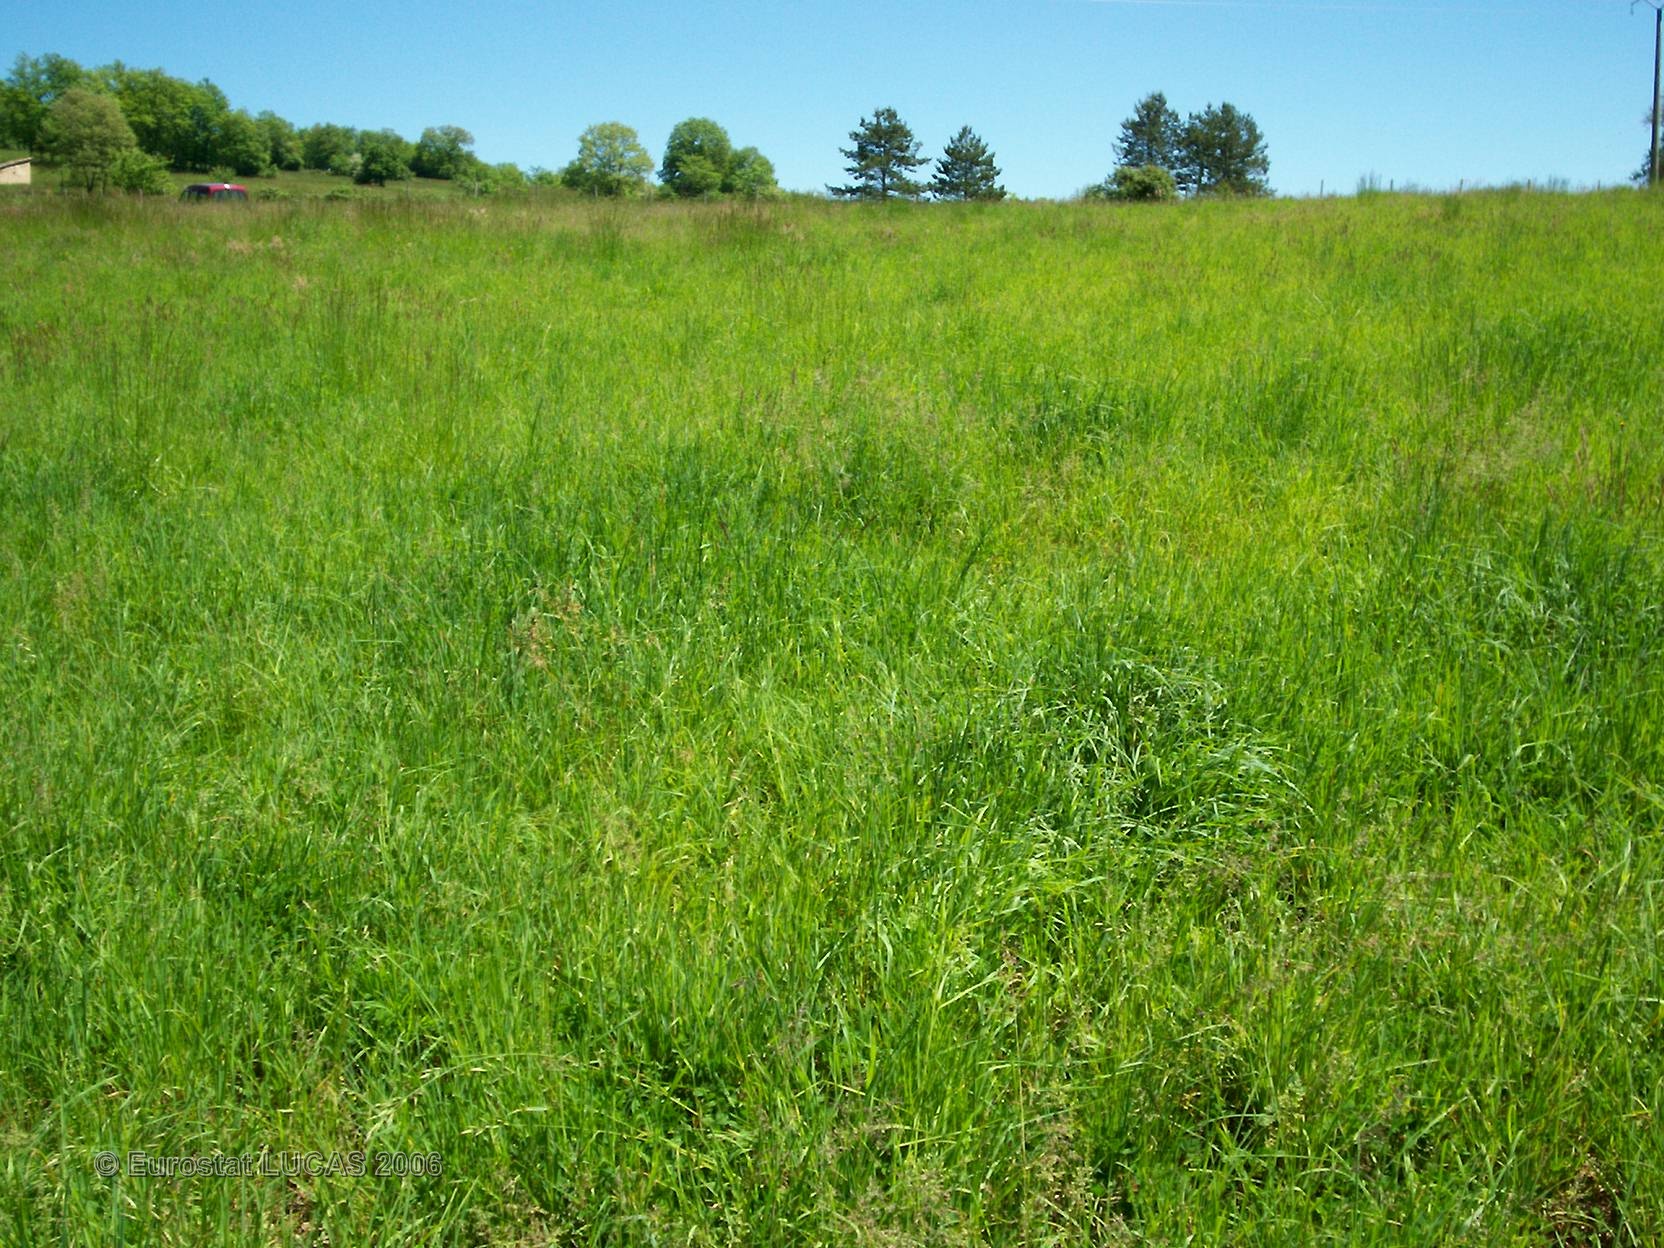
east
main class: Grassland
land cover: Grassland without tree/shrub cover
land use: Agriculture (excluding fallow land and kitchen gardens)
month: May
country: FR
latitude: 43.1865
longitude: 0.8850
